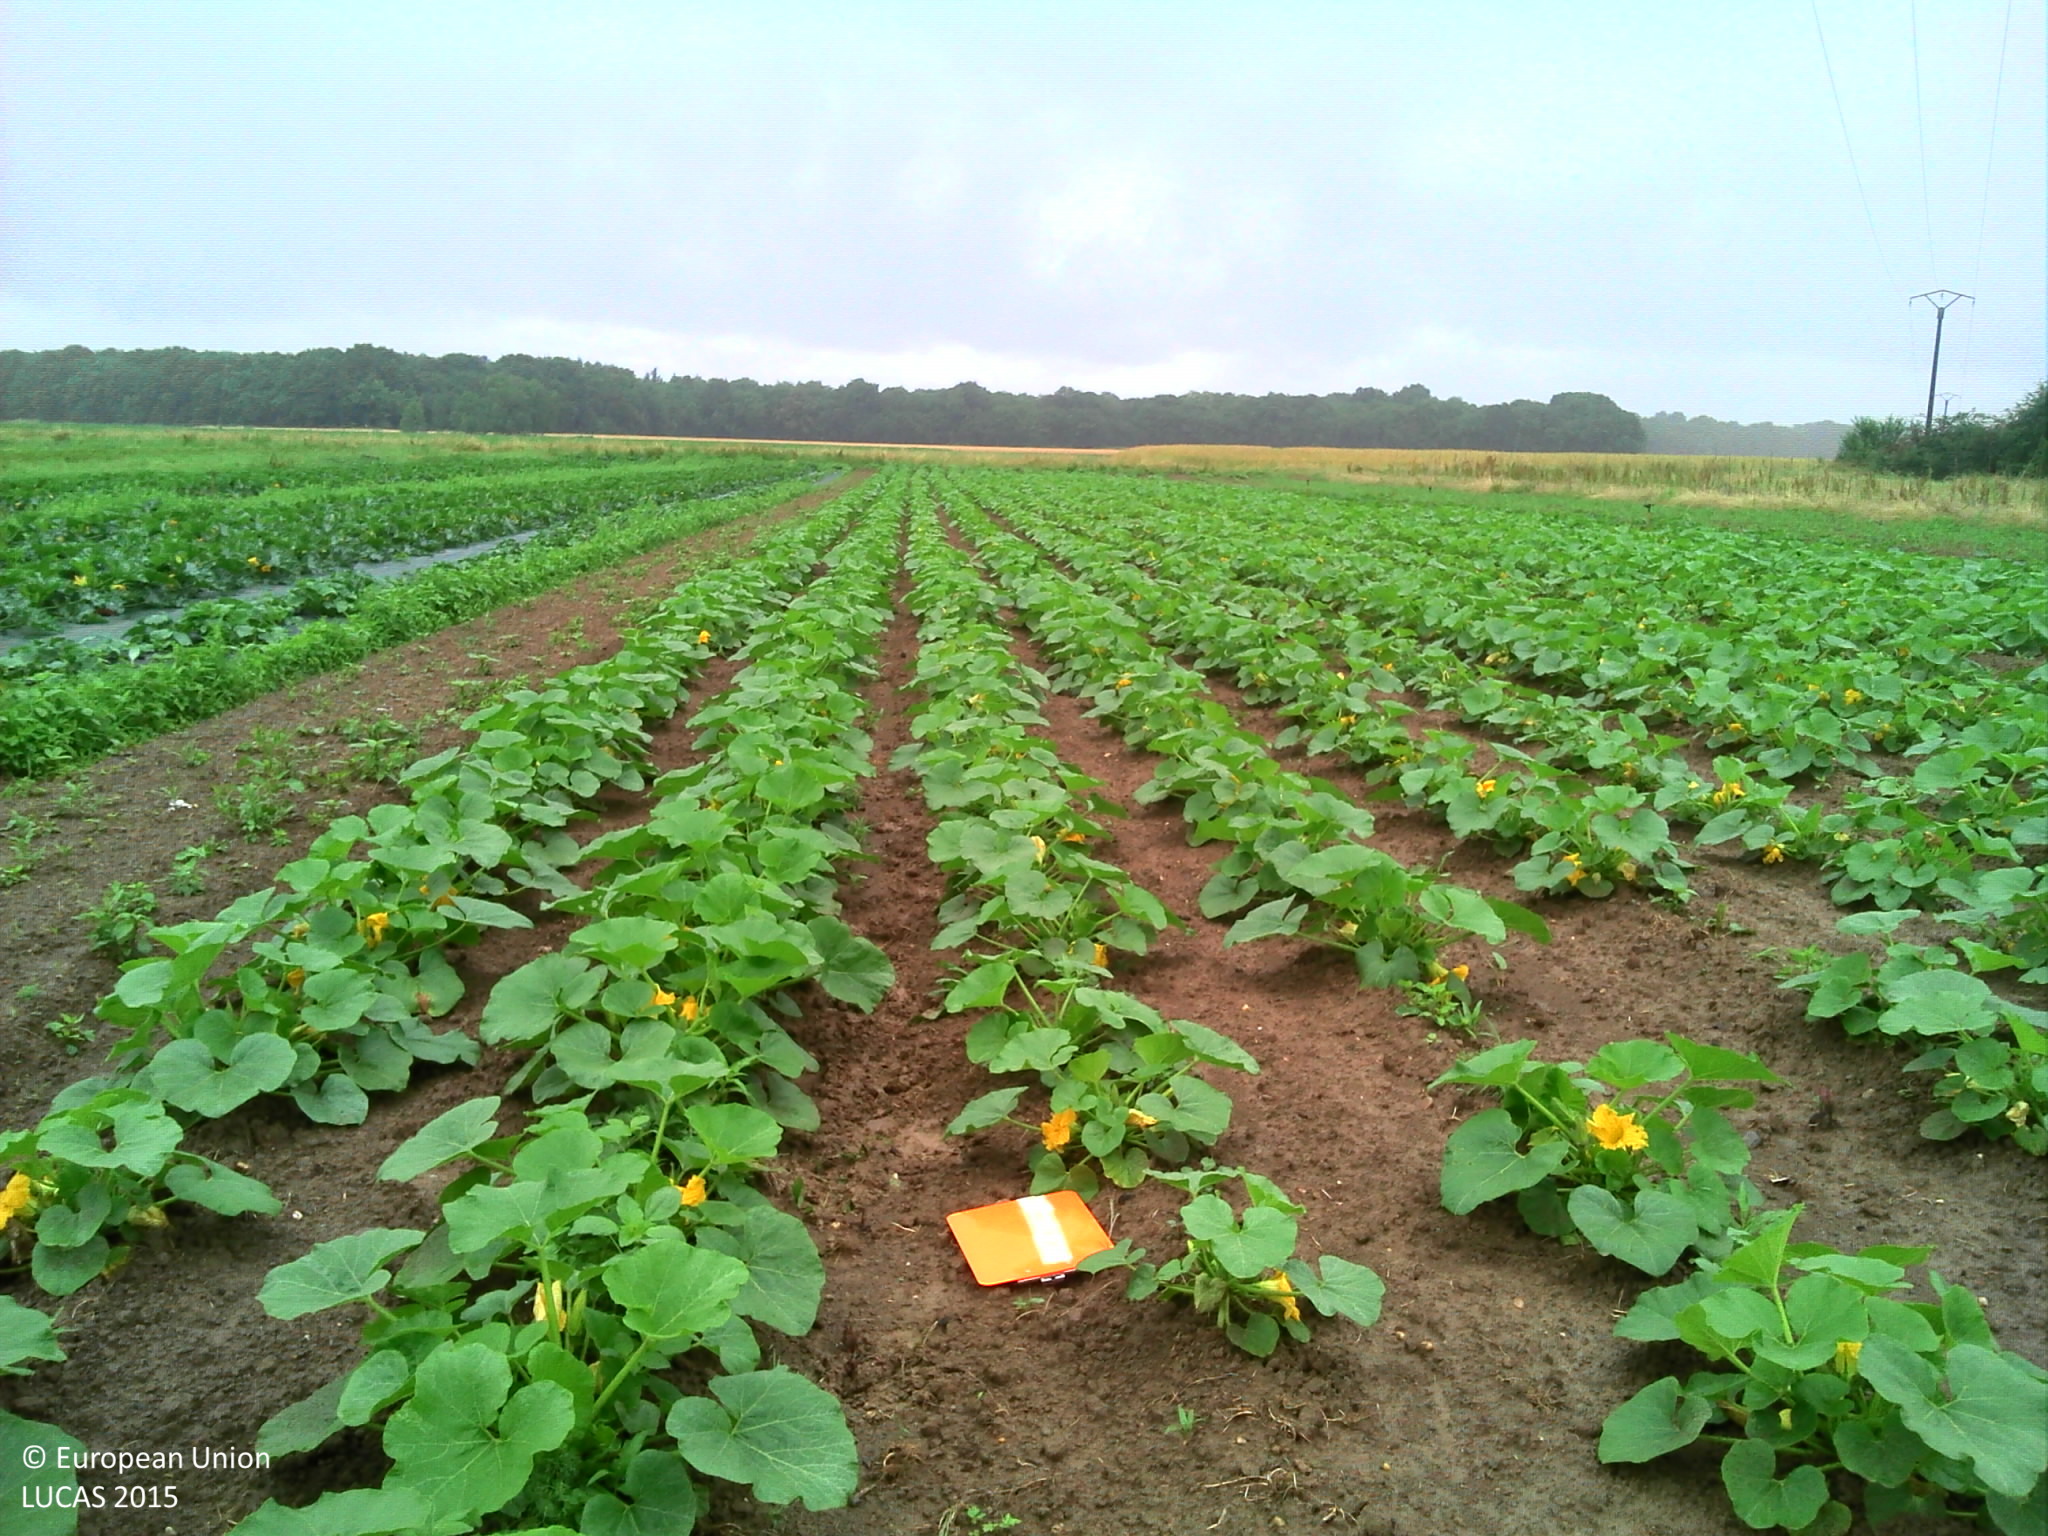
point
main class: Cropland
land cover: Other fresh vegetables
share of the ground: 50 - 75 %
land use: Agriculture (excluding fallow land and kitchen gardens)
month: June
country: FR
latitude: 46.9945
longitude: 5.4650
